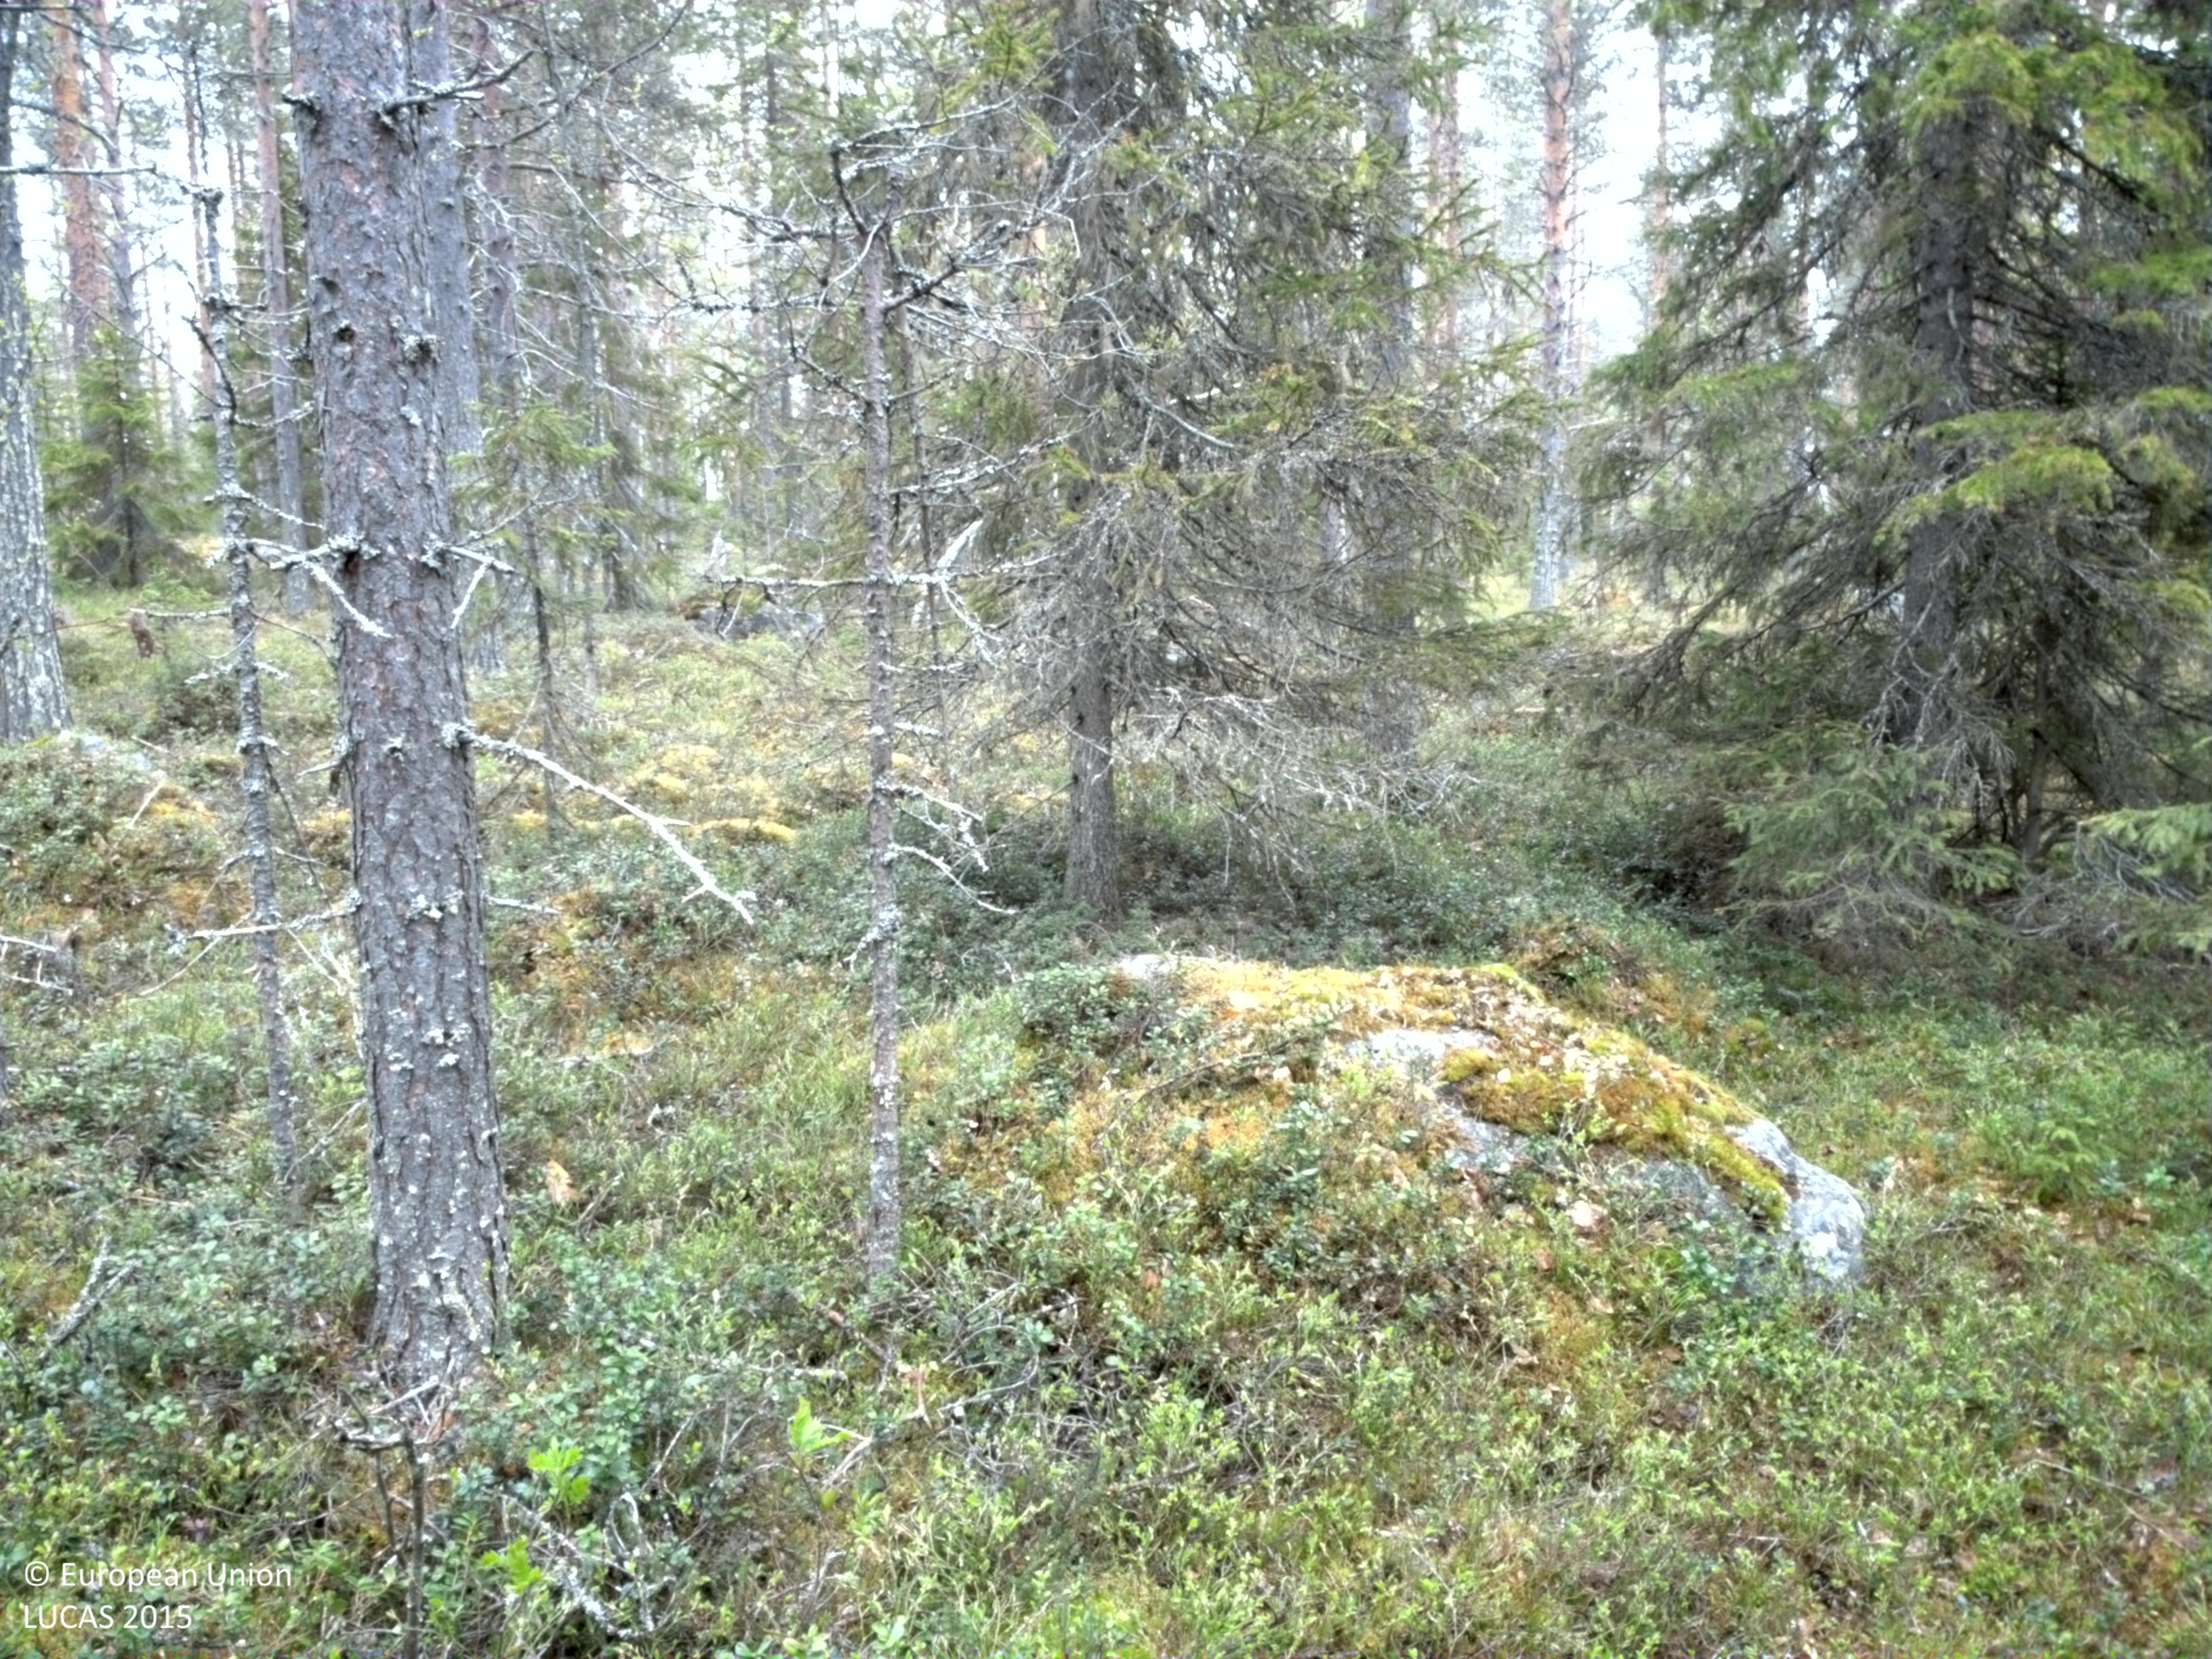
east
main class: Woodland
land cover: Pine dominated coniferous woodland
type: boreal forest
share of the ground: 50 - 75 %
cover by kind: coniferous forest trees 65 %, shrubs 30 %, broadleaved forest trees 5 %
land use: Forestry
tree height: > 5 m
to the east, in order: Pine dominated coniferous woodland; Peatbogs; Pine dominated coniferous woodland; Pine dominated mixed woodland; Pine dominated coniferous woodland
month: June
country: SE
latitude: 65.9885
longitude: 23.0448
